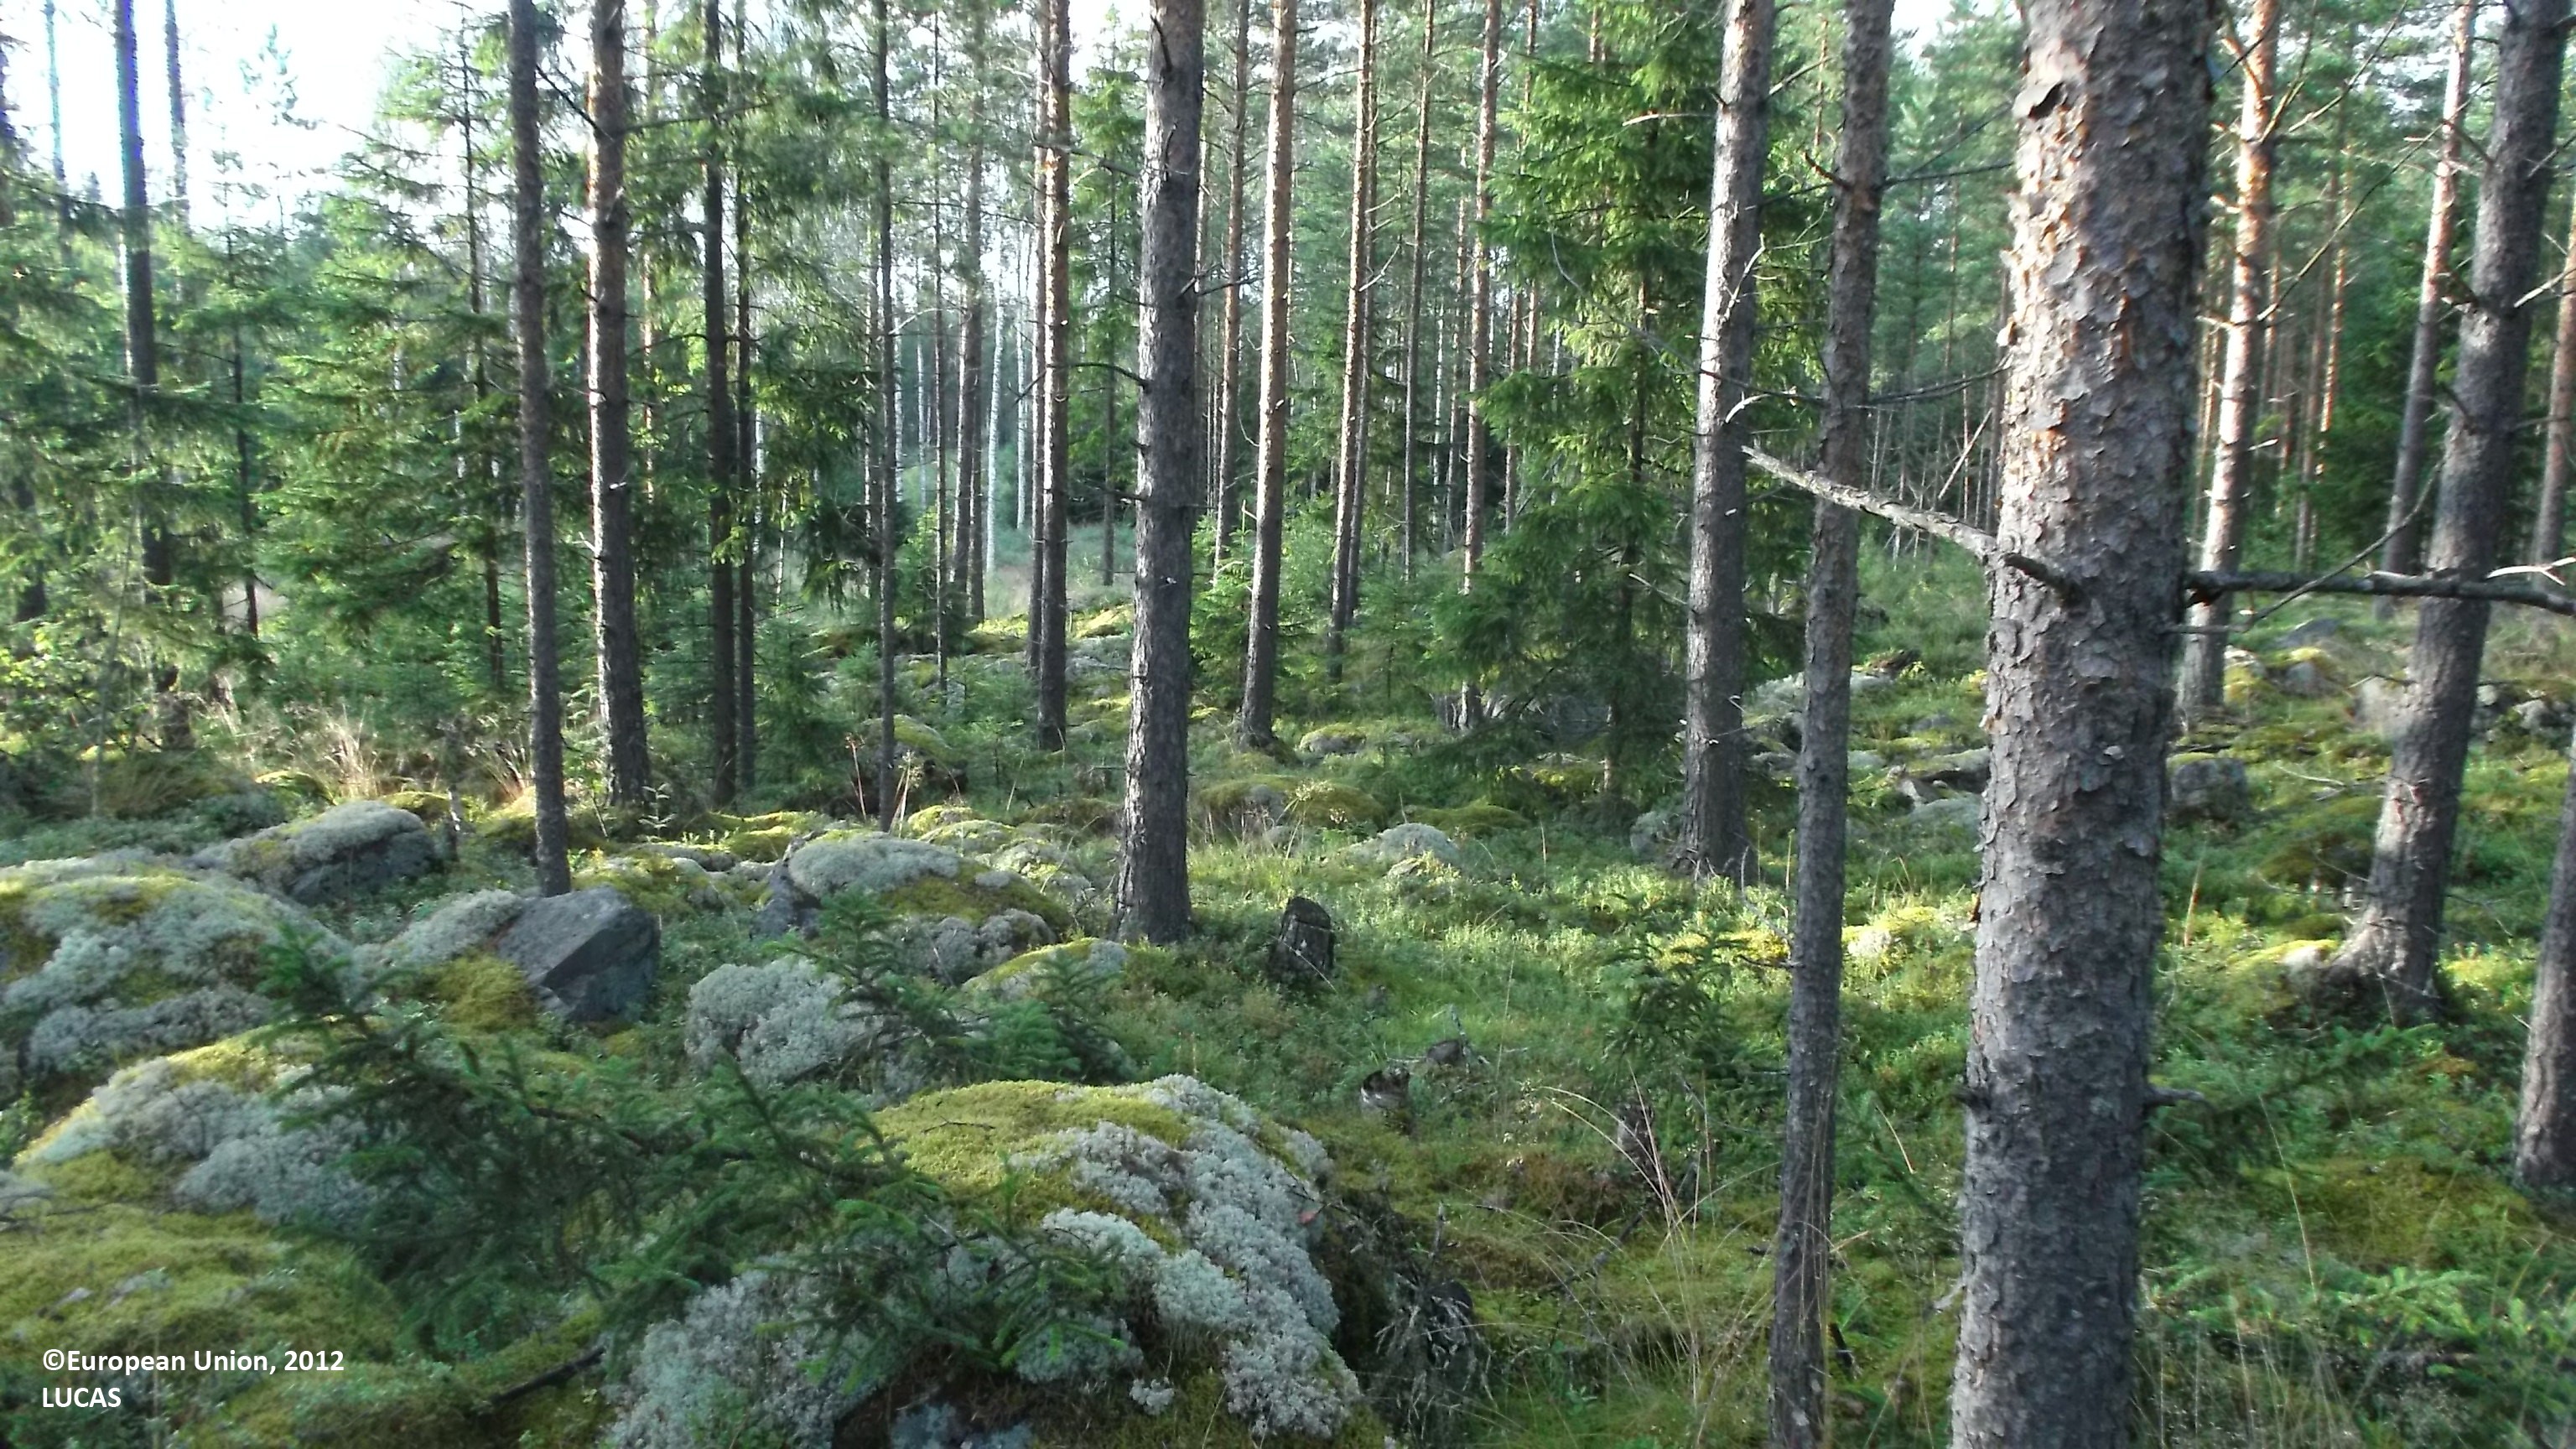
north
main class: Woodland
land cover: Pine dominated coniferous woodland
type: boreal forest
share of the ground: 25 - 50 %
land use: Forestry
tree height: > 5 m
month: August
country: FI
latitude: 63.8717
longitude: 23.3048
